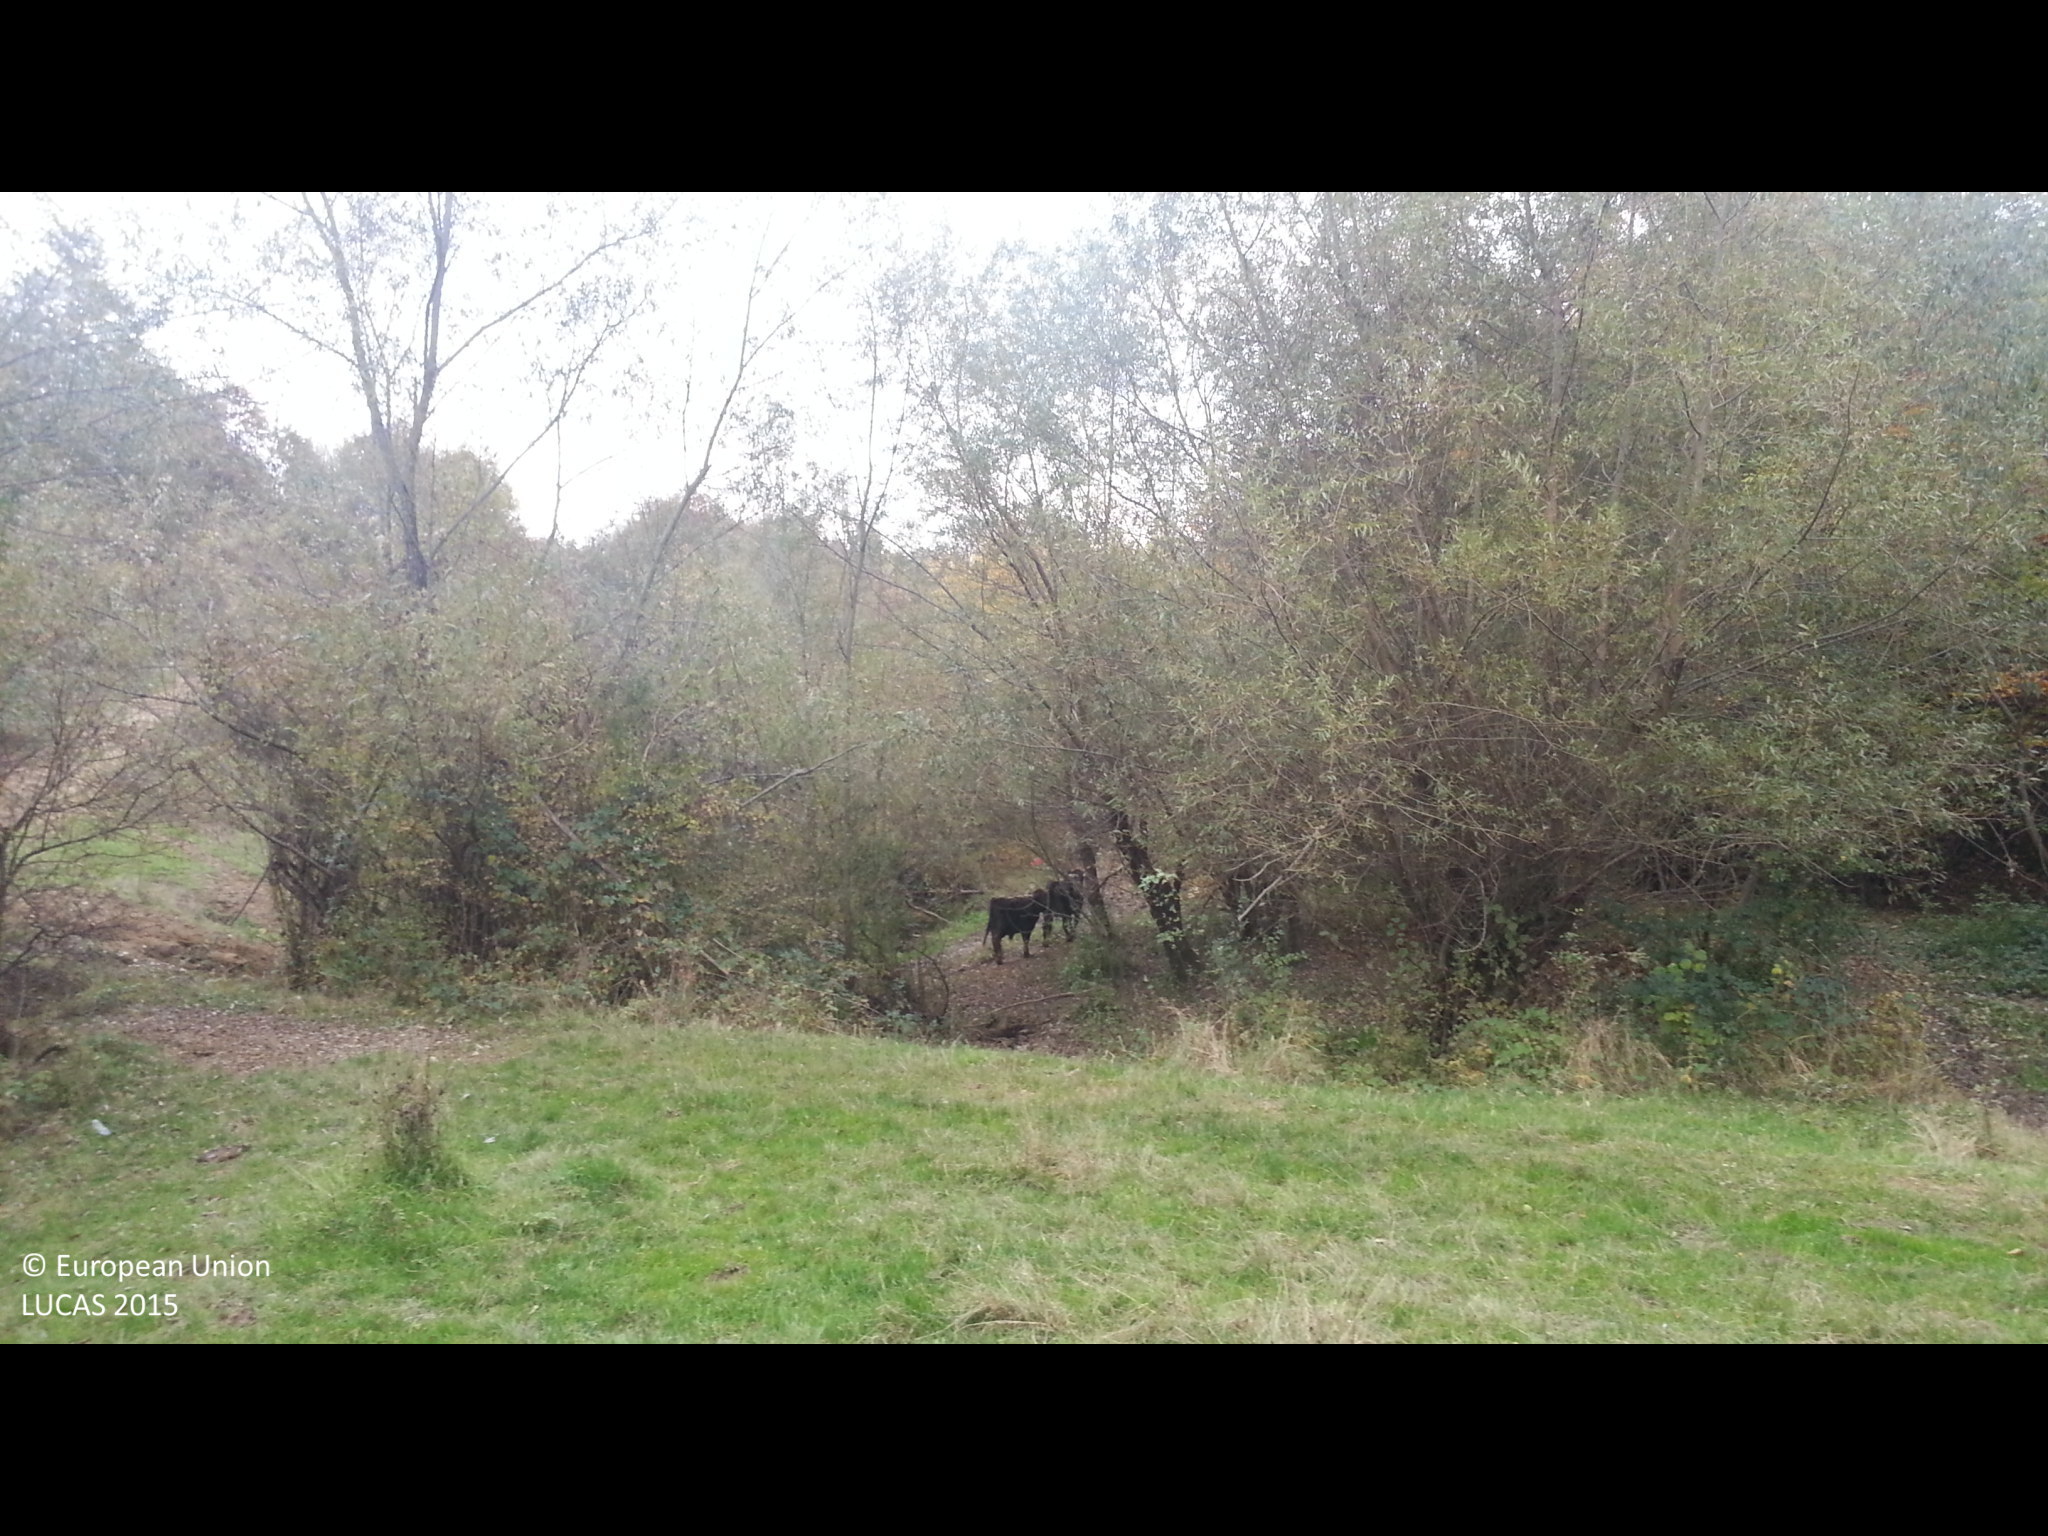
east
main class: Grassland
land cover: Grassland with sparse tree/shrub cover
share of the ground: > 75 %
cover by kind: herbaceous plants 90 %, broadleaved forest trees 5 %, shrubs 5 %
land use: Agriculture (excluding fallow land and kitchen gardens)
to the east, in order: Grassland with sparse tree/shrub cover; Tracks; Grassland with sparse tree/shrub cover; Broadleaved woodland; Rivers and streams; Broadleaved woodland; Electric lines; Broadleaved woodland; Grassland with sparse tree/shrub cover; Tracks; Shrubland without tree cover
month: October
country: BG
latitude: 42.9490
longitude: 23.6589
